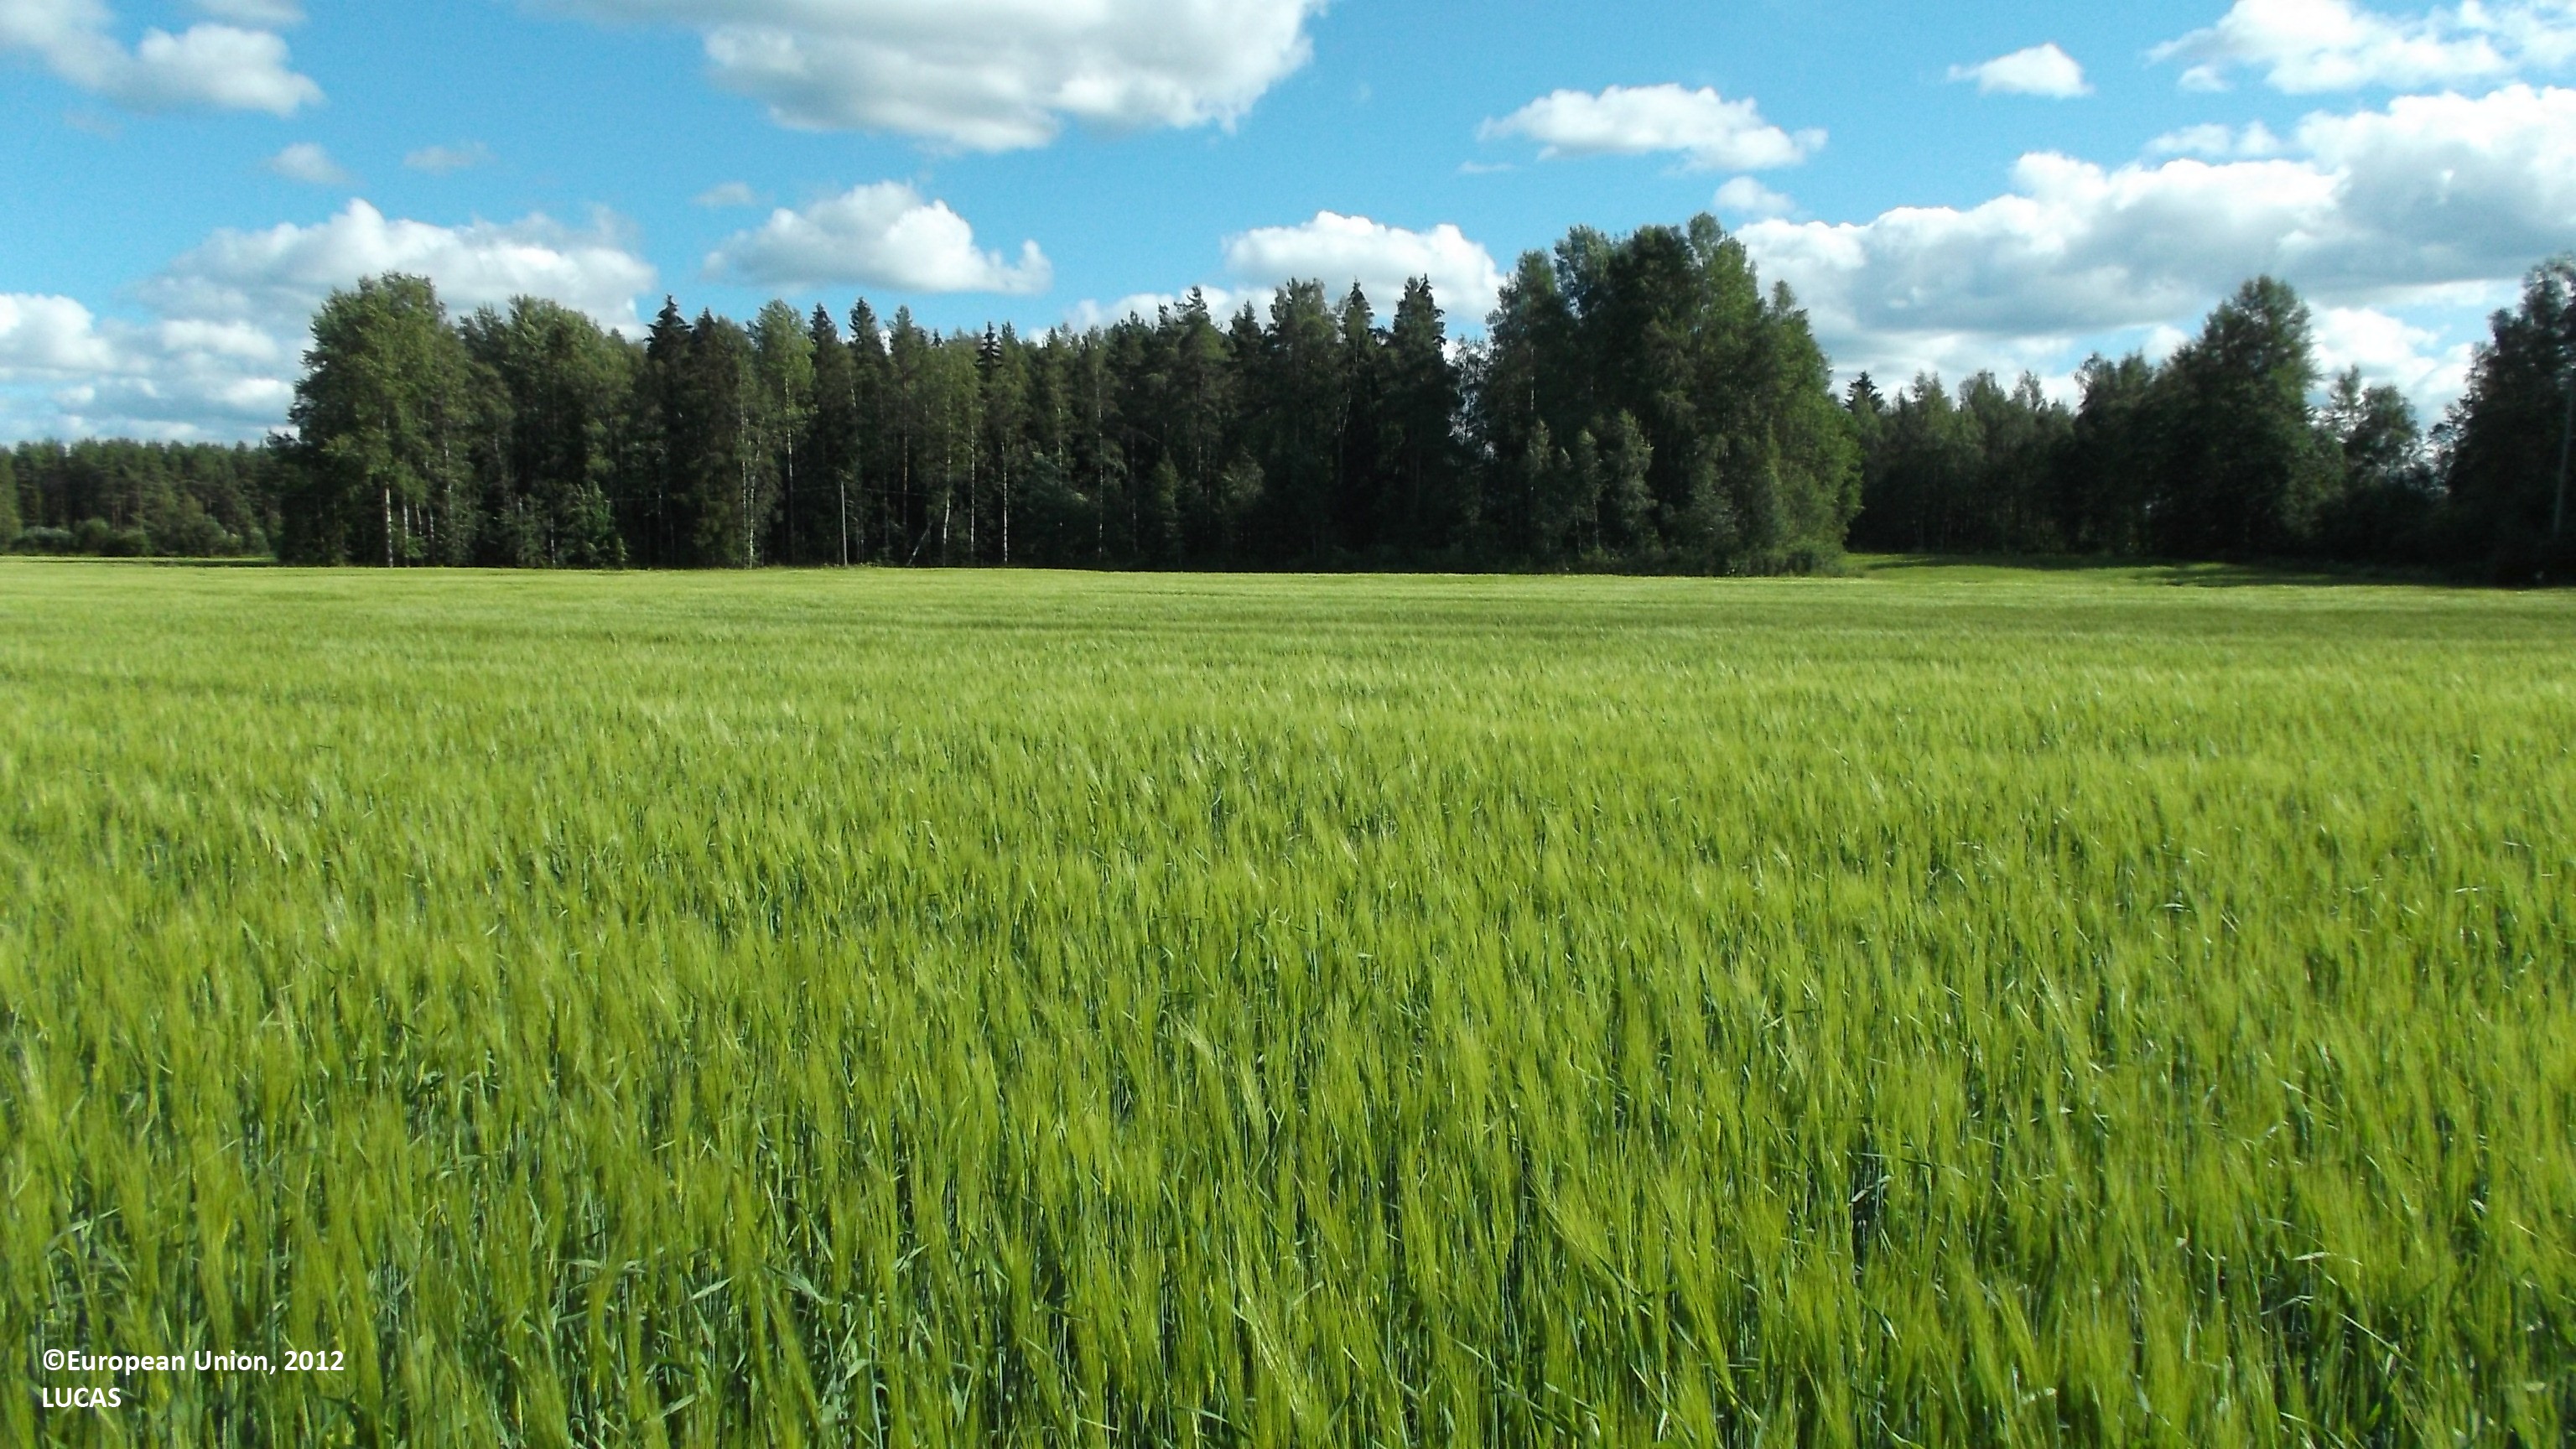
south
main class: Cropland
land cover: Barley
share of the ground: > 75 %
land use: Agriculture (excluding fallow land and kitchen gardens)
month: July
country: FI
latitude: 63.5771
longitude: 22.8823
